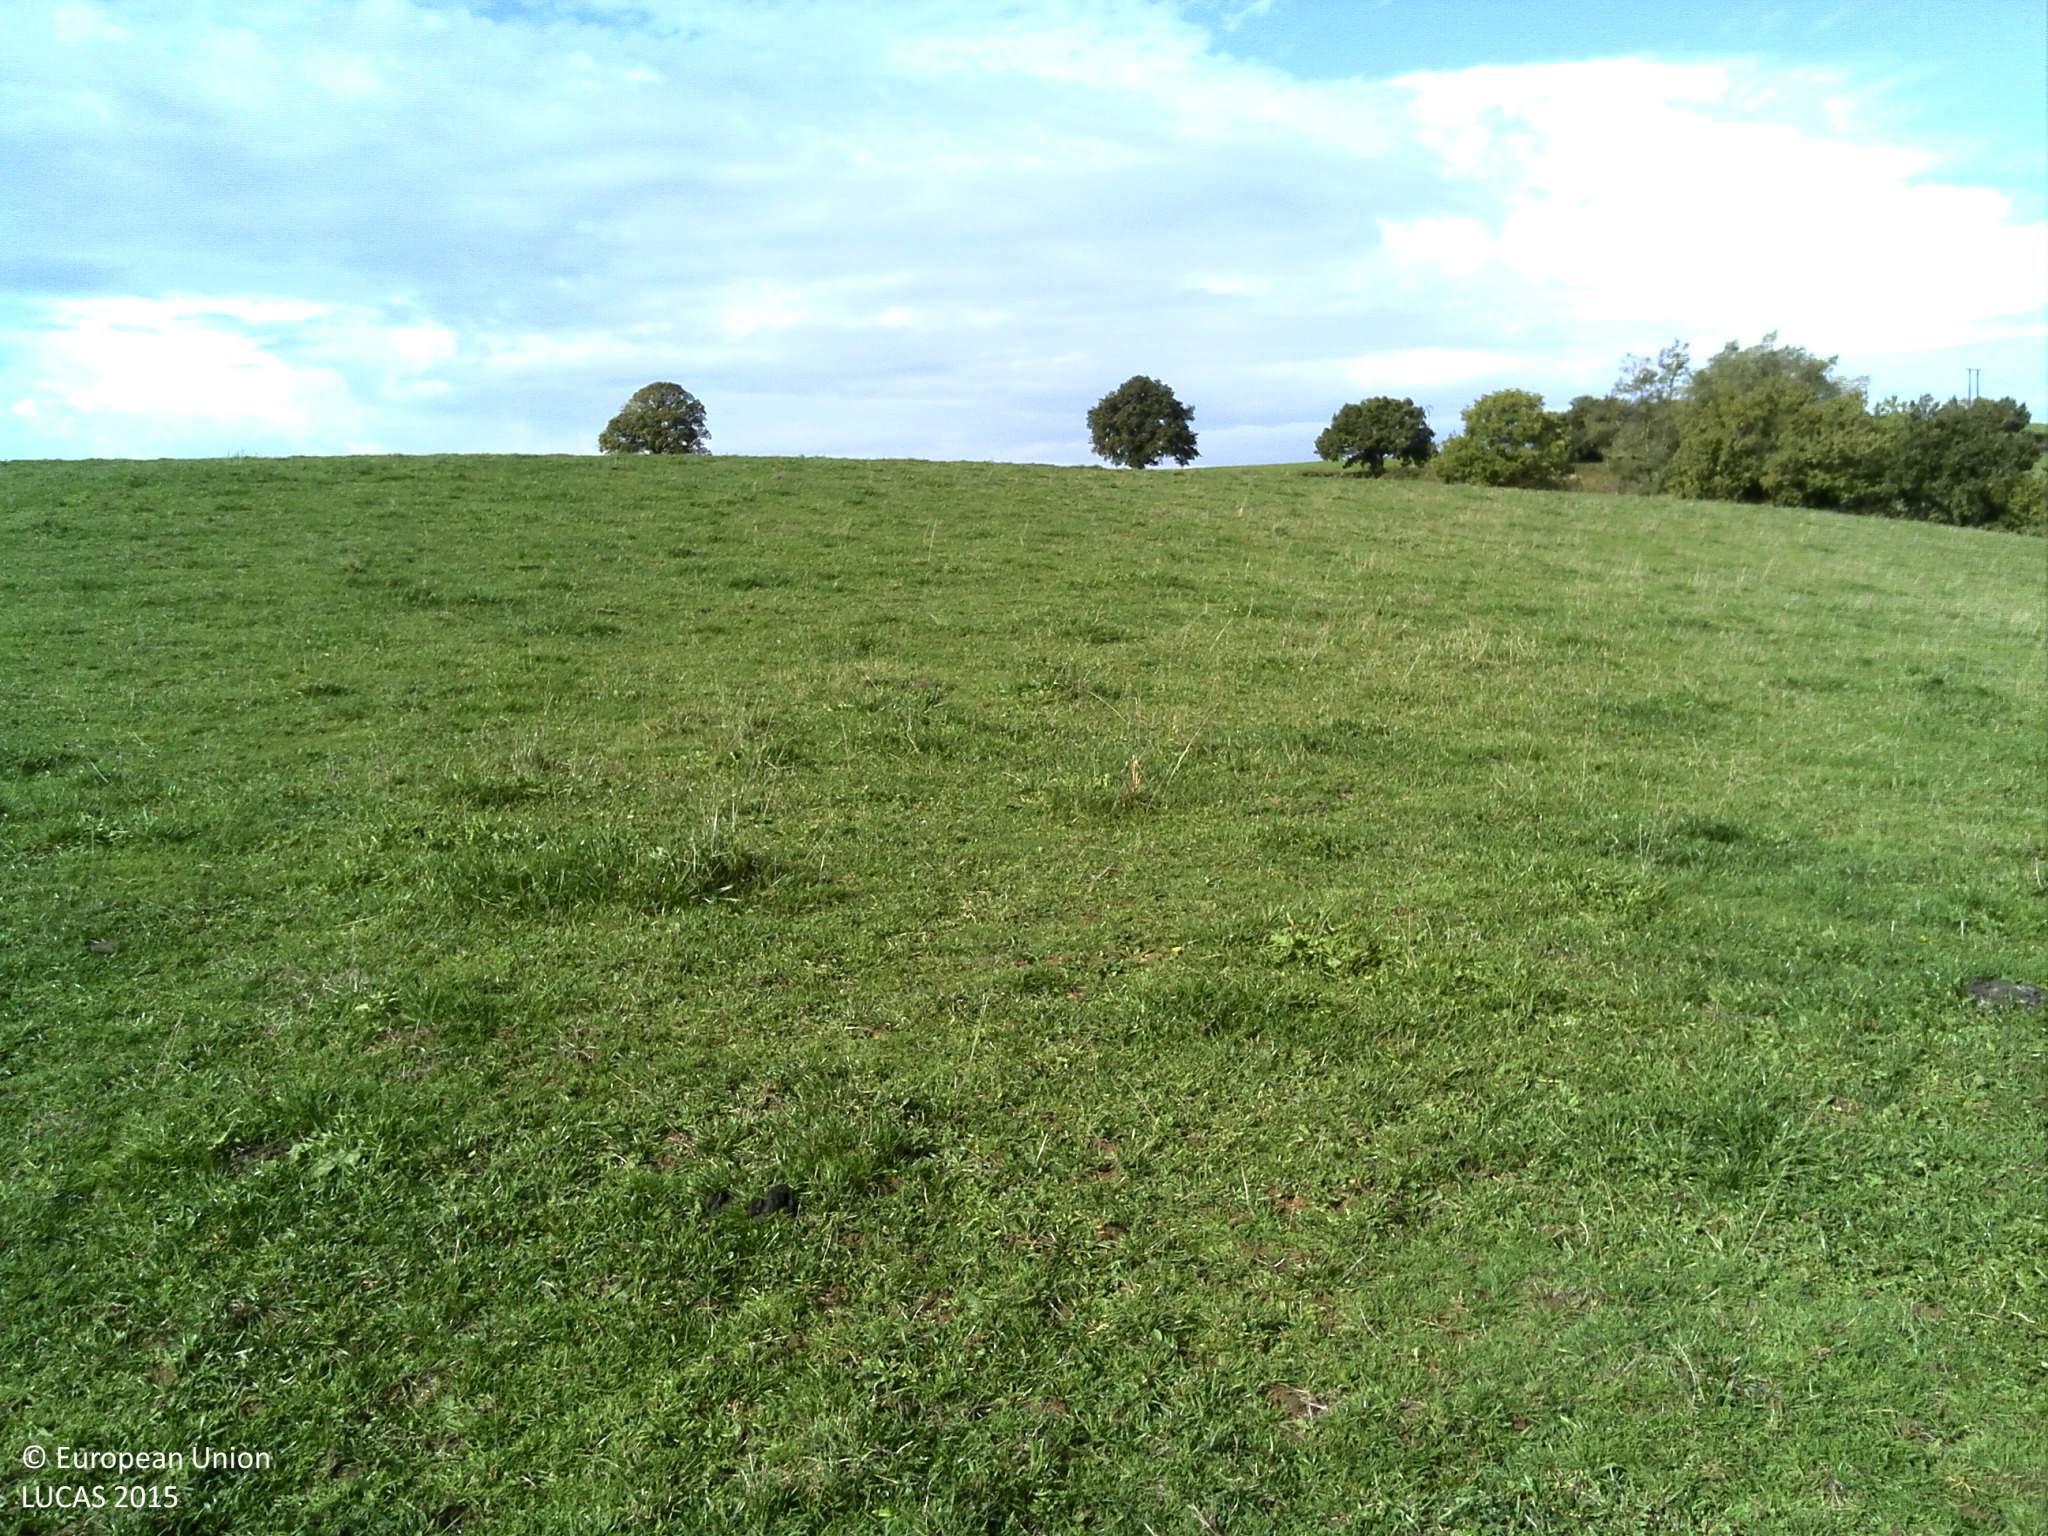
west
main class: Grassland
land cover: Grassland without tree/shrub cover
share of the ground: > 75 %
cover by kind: herbaceous plants 100 %
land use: Agriculture (excluding fallow land and kitchen gardens)
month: October
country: FR
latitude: 46.6553
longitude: 4.0543
